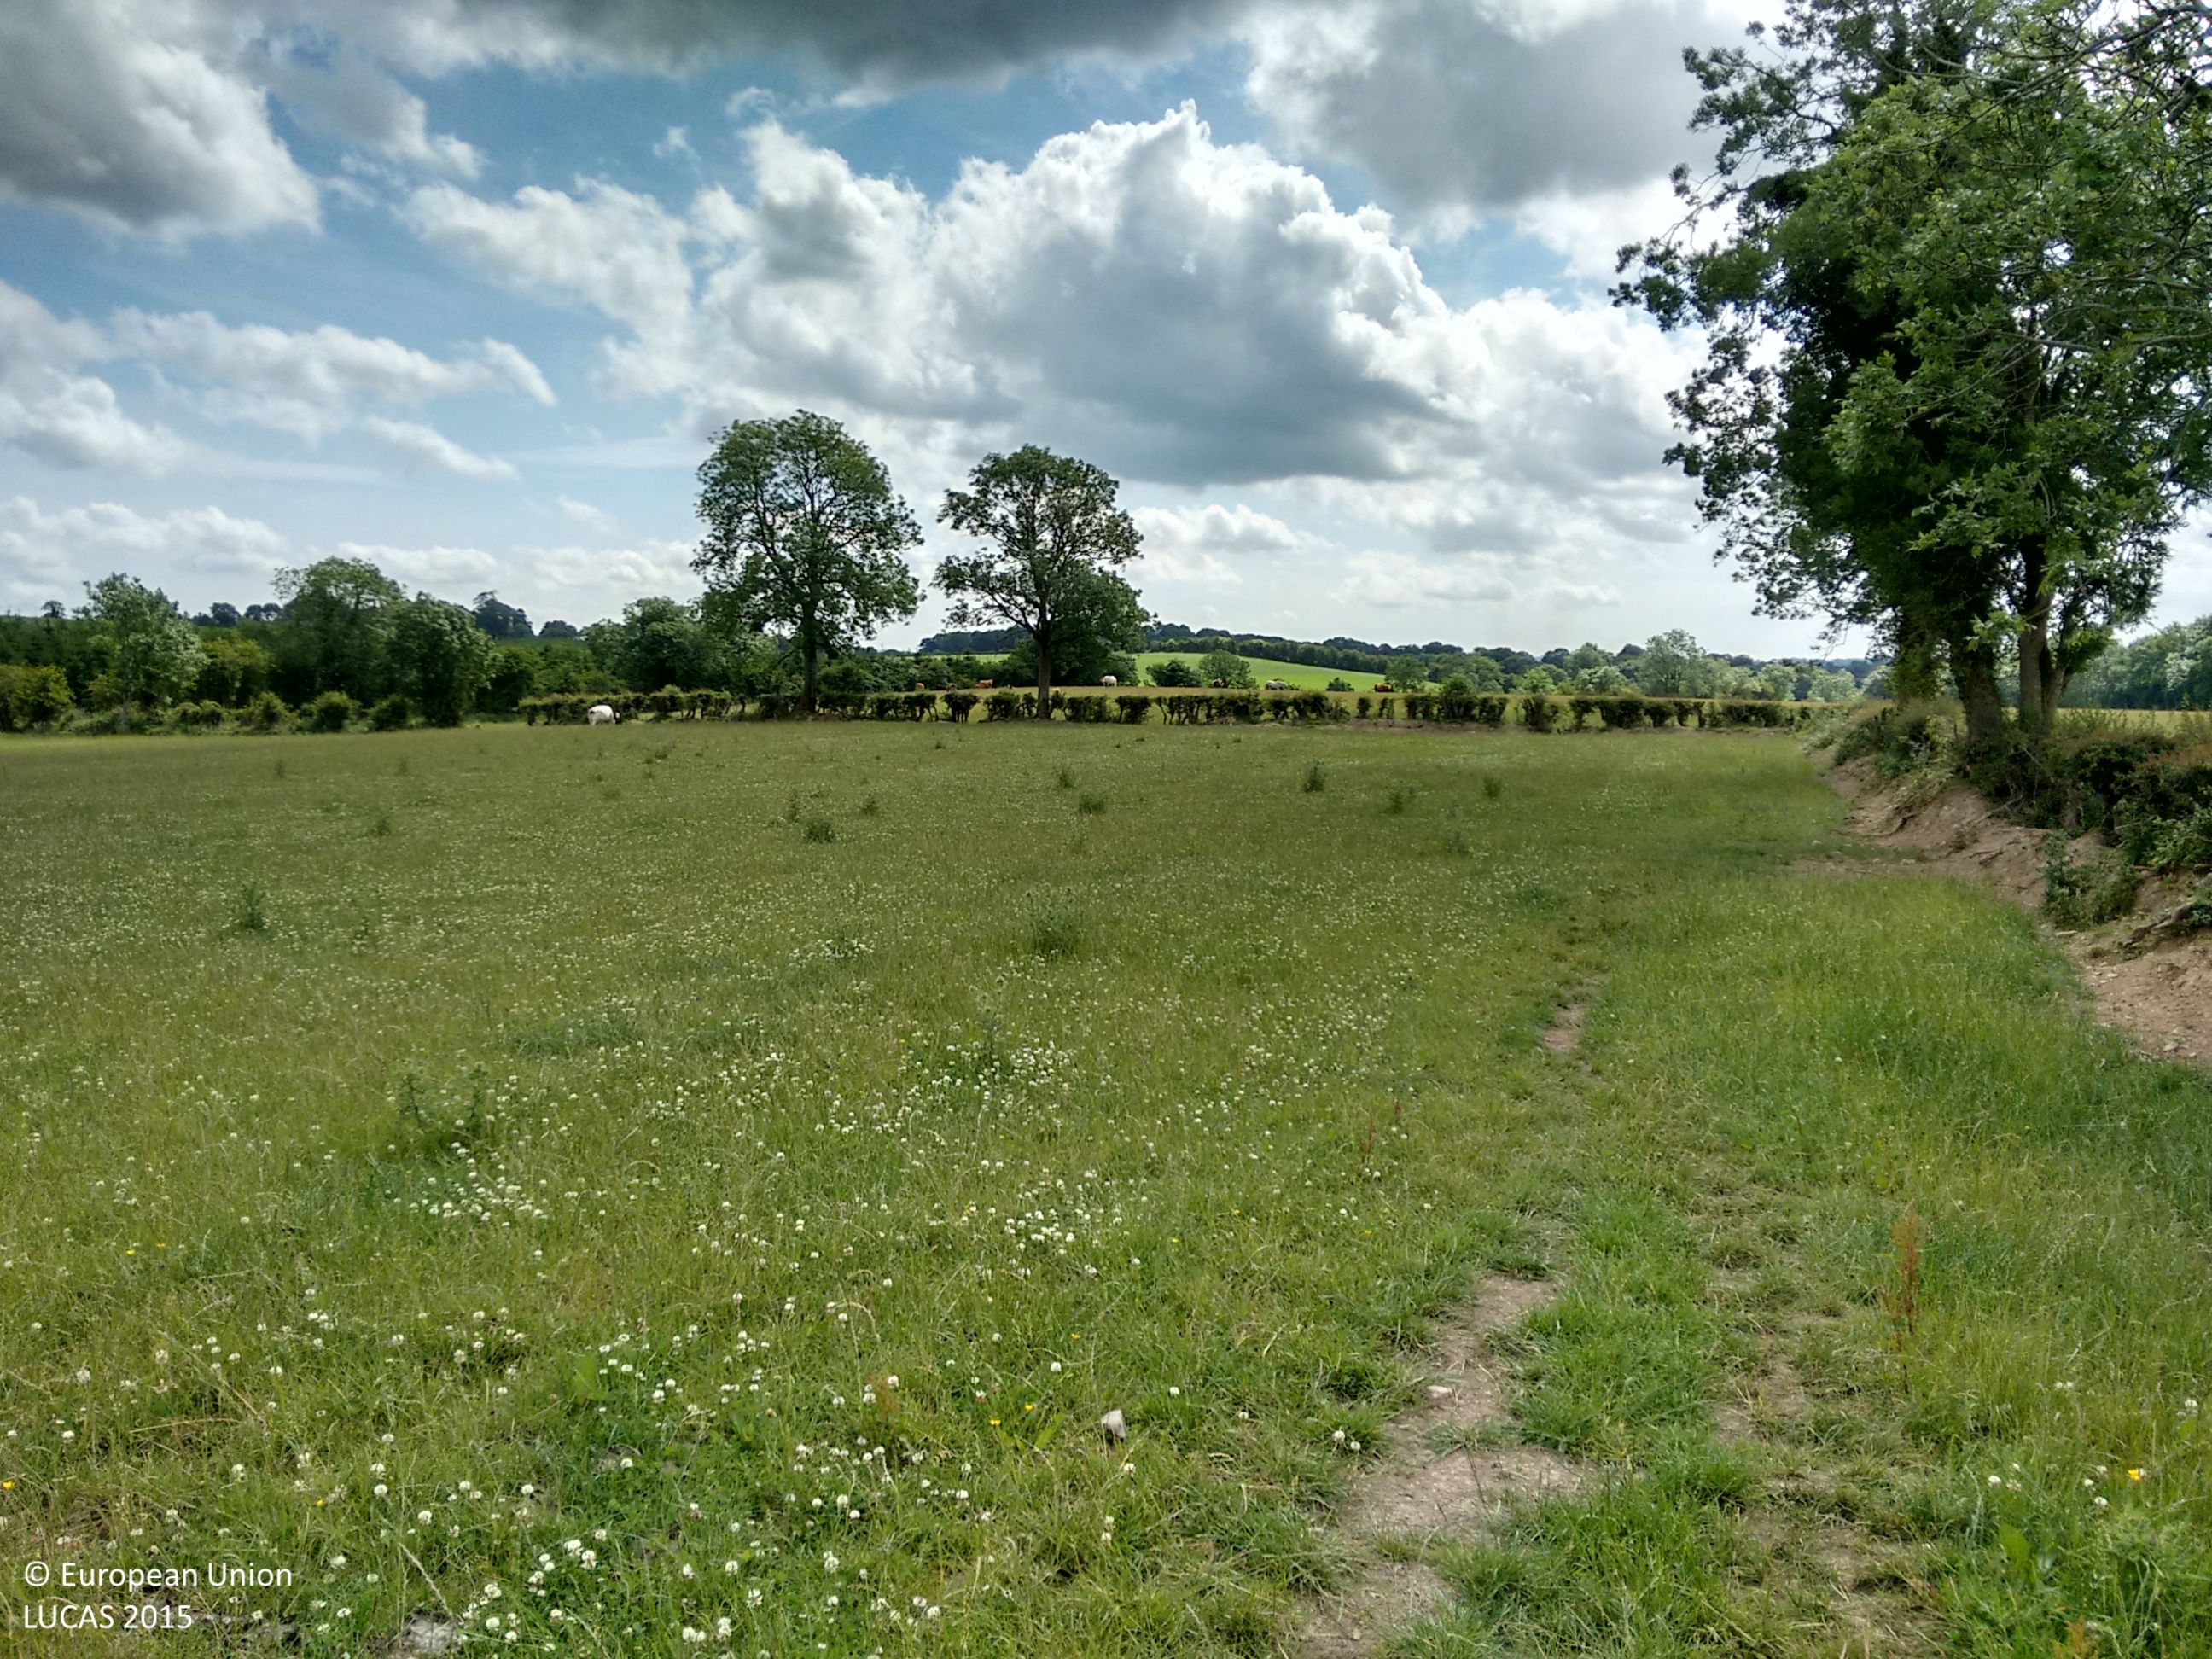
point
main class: Grassland
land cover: Grassland without tree/shrub cover
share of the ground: > 75 %
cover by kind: herbaceous plants 100 %
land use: Agriculture (excluding fallow land and kitchen gardens)
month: July
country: IE
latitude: 53.7991
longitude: -6.7901
